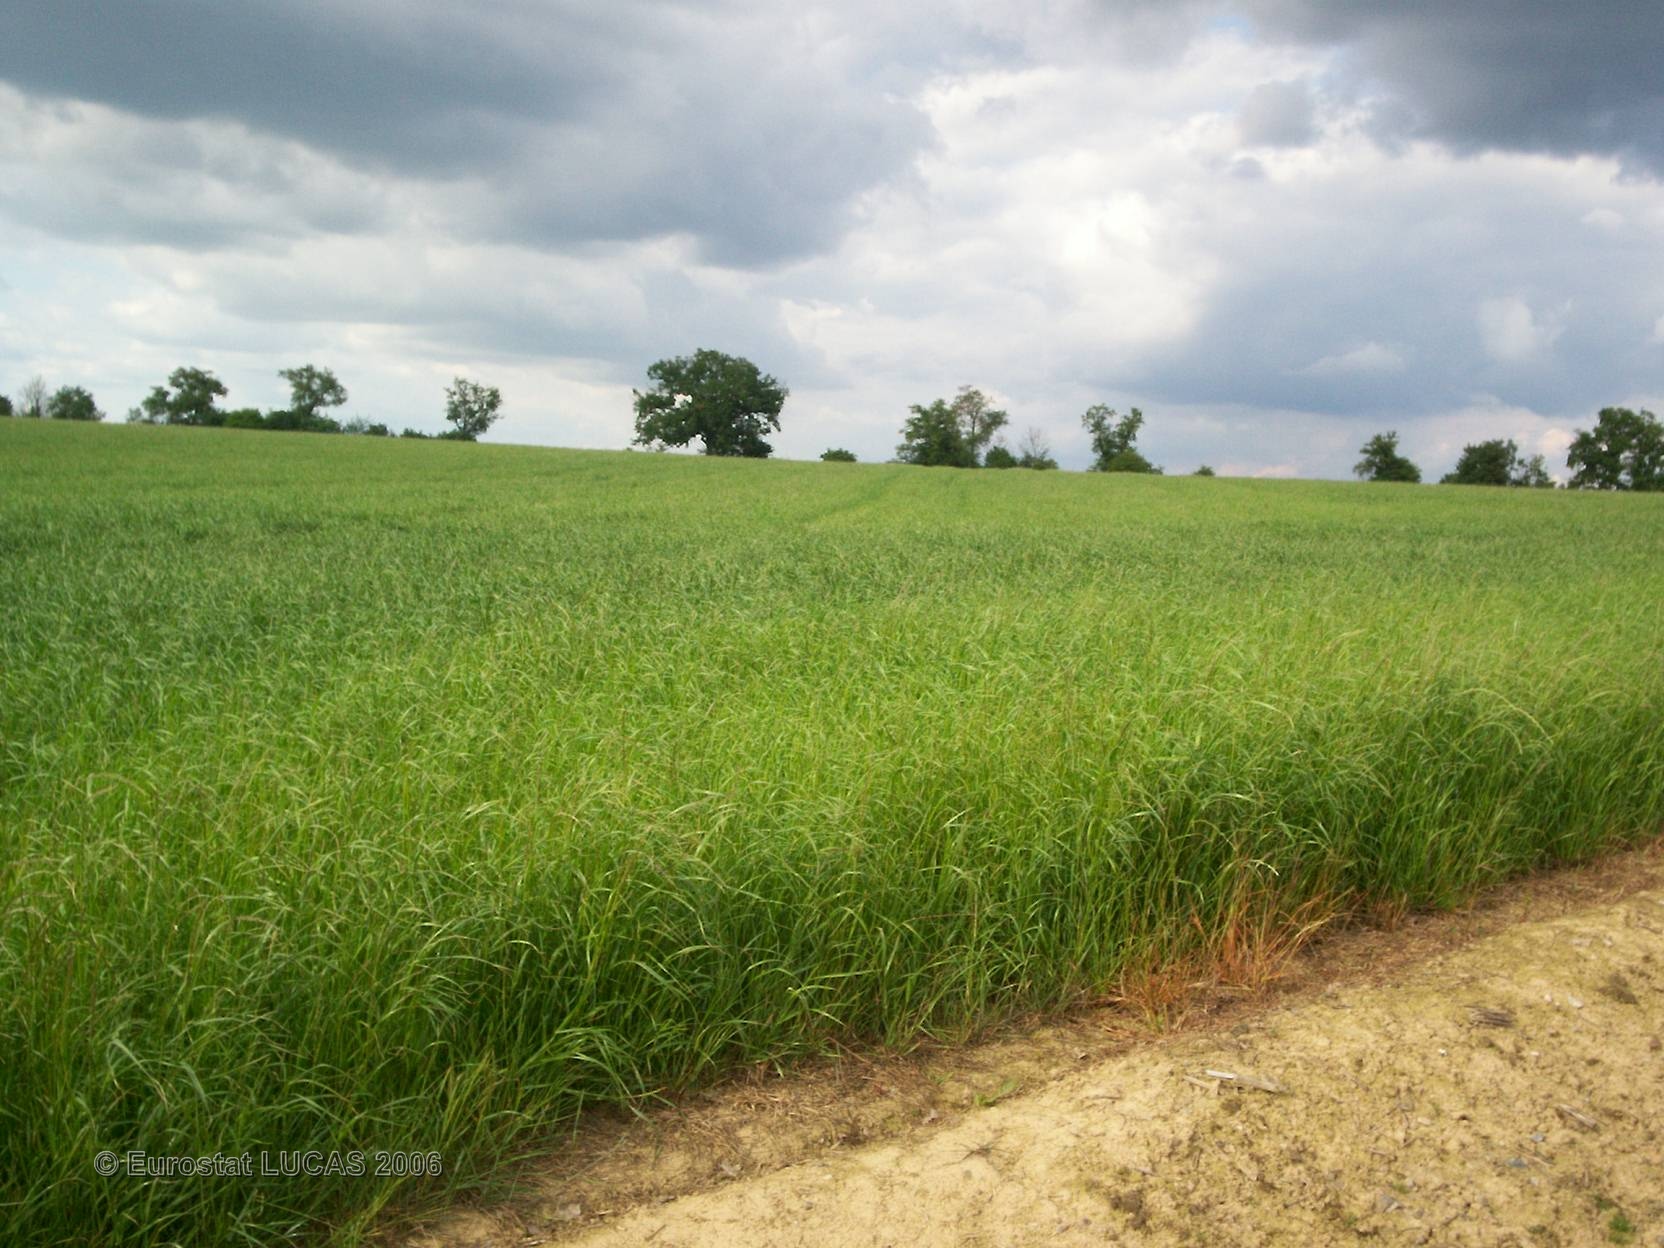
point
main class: Grassland
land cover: Grassland without tree/shrub cover
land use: Agriculture (excluding fallow land and kitchen gardens)
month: May
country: FR
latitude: 47.7769
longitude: -0.4814
